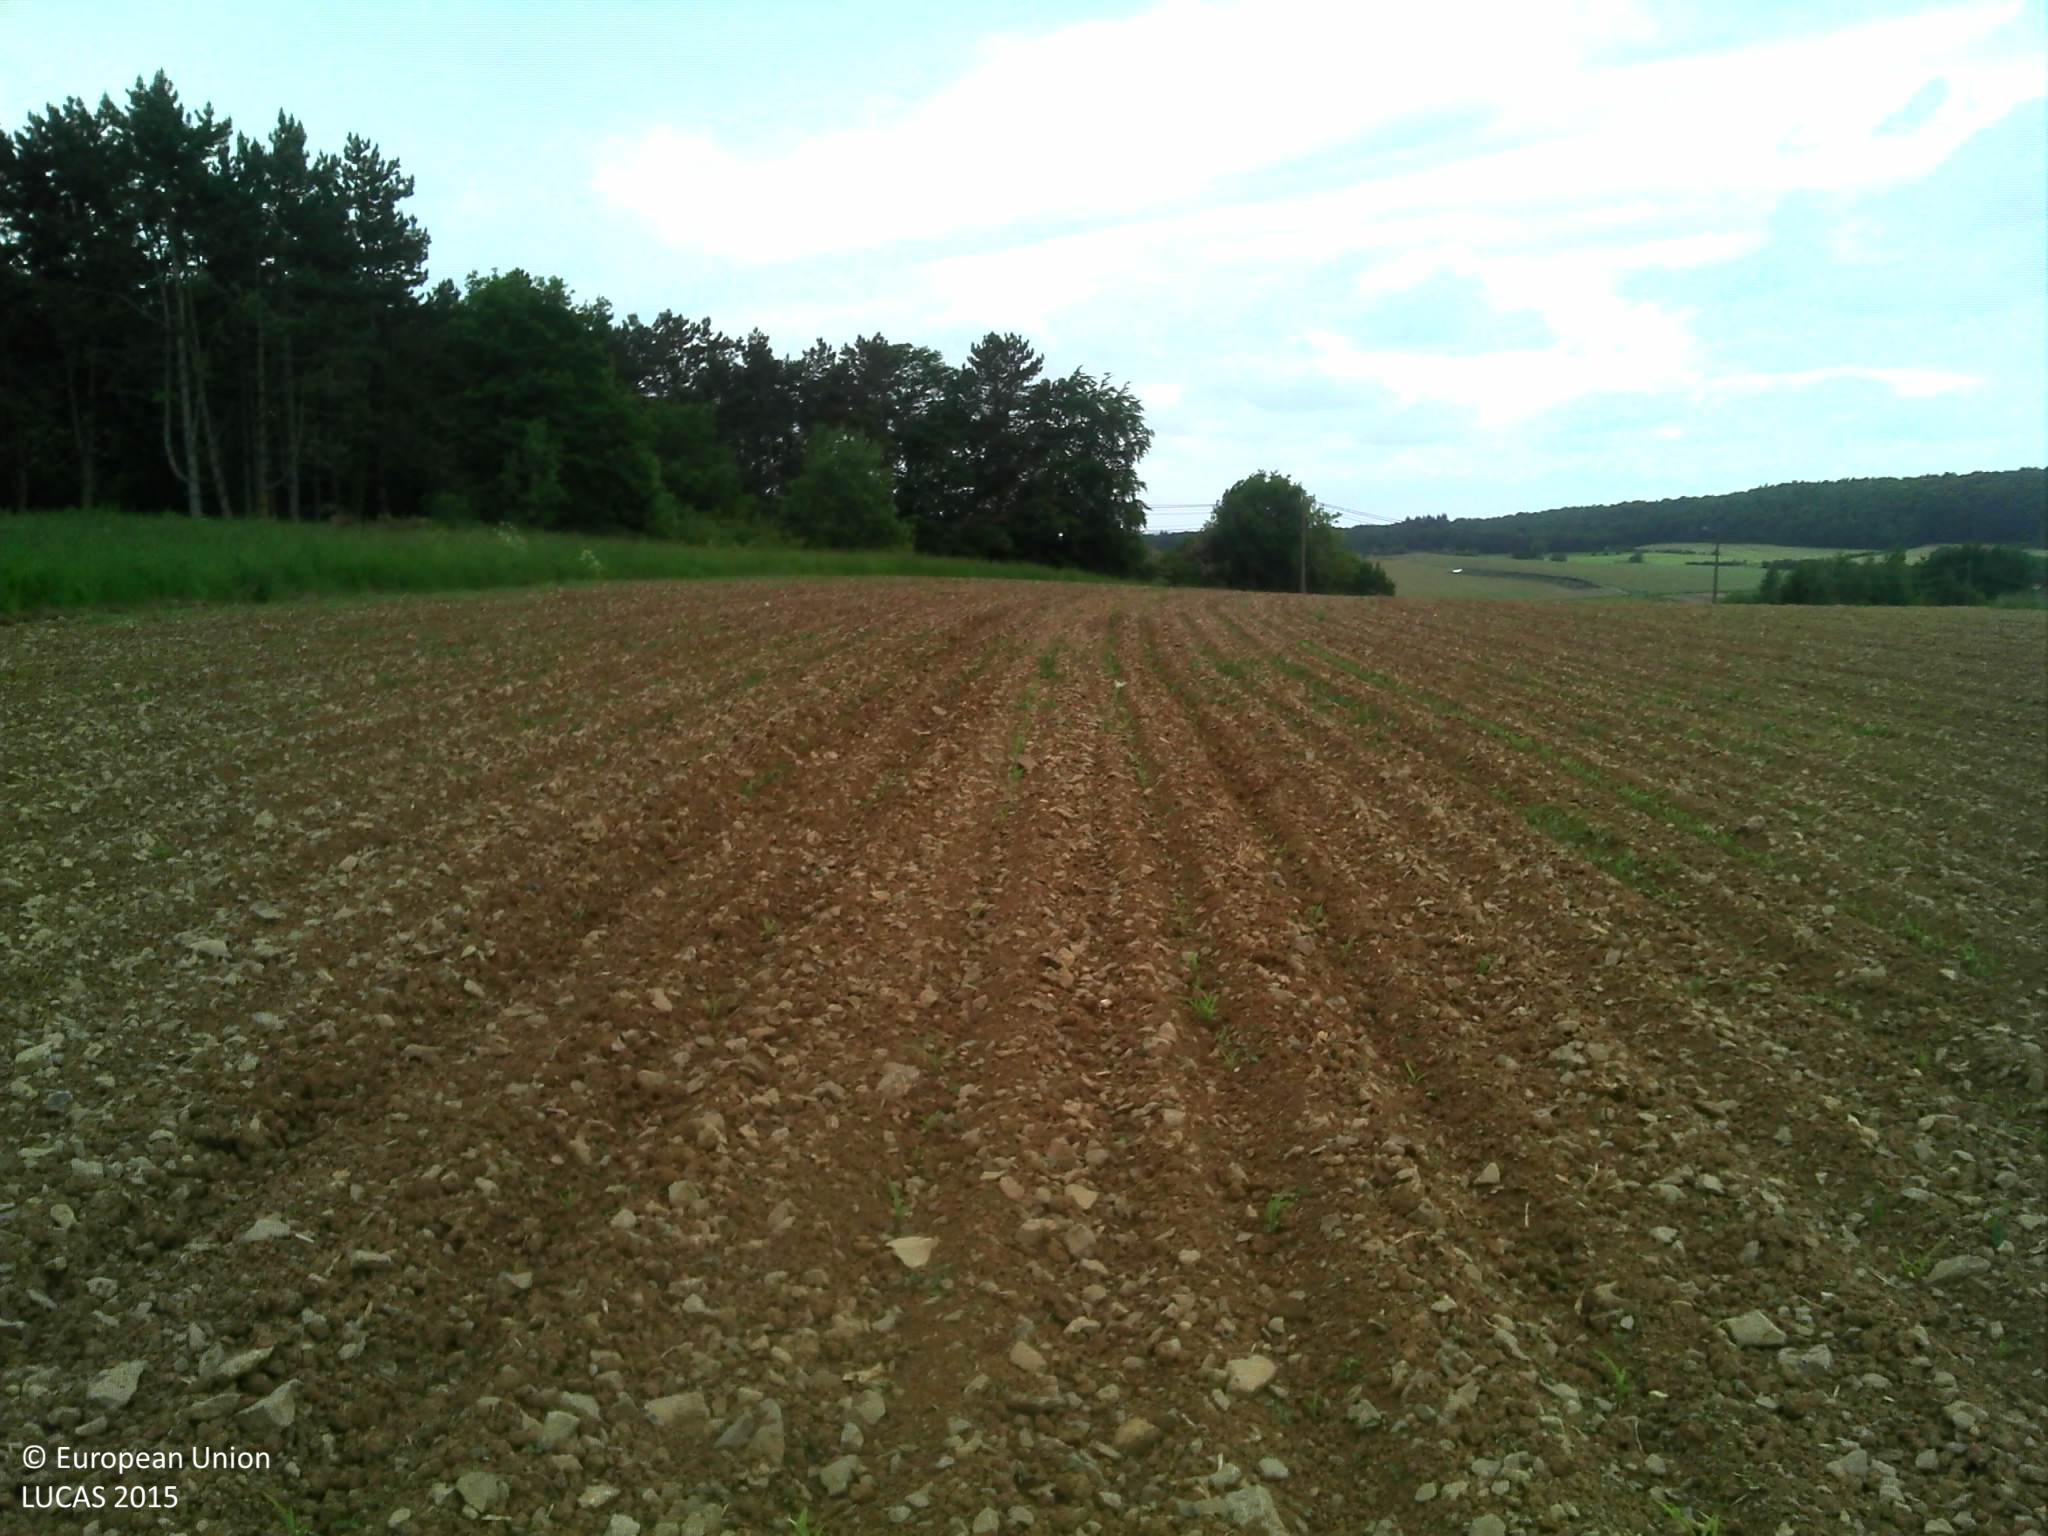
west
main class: Cropland
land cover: Maize
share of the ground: < 10 %
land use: Agriculture (excluding fallow land and kitchen gardens)
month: May
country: BE
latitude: 50.1384
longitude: 5.2267
